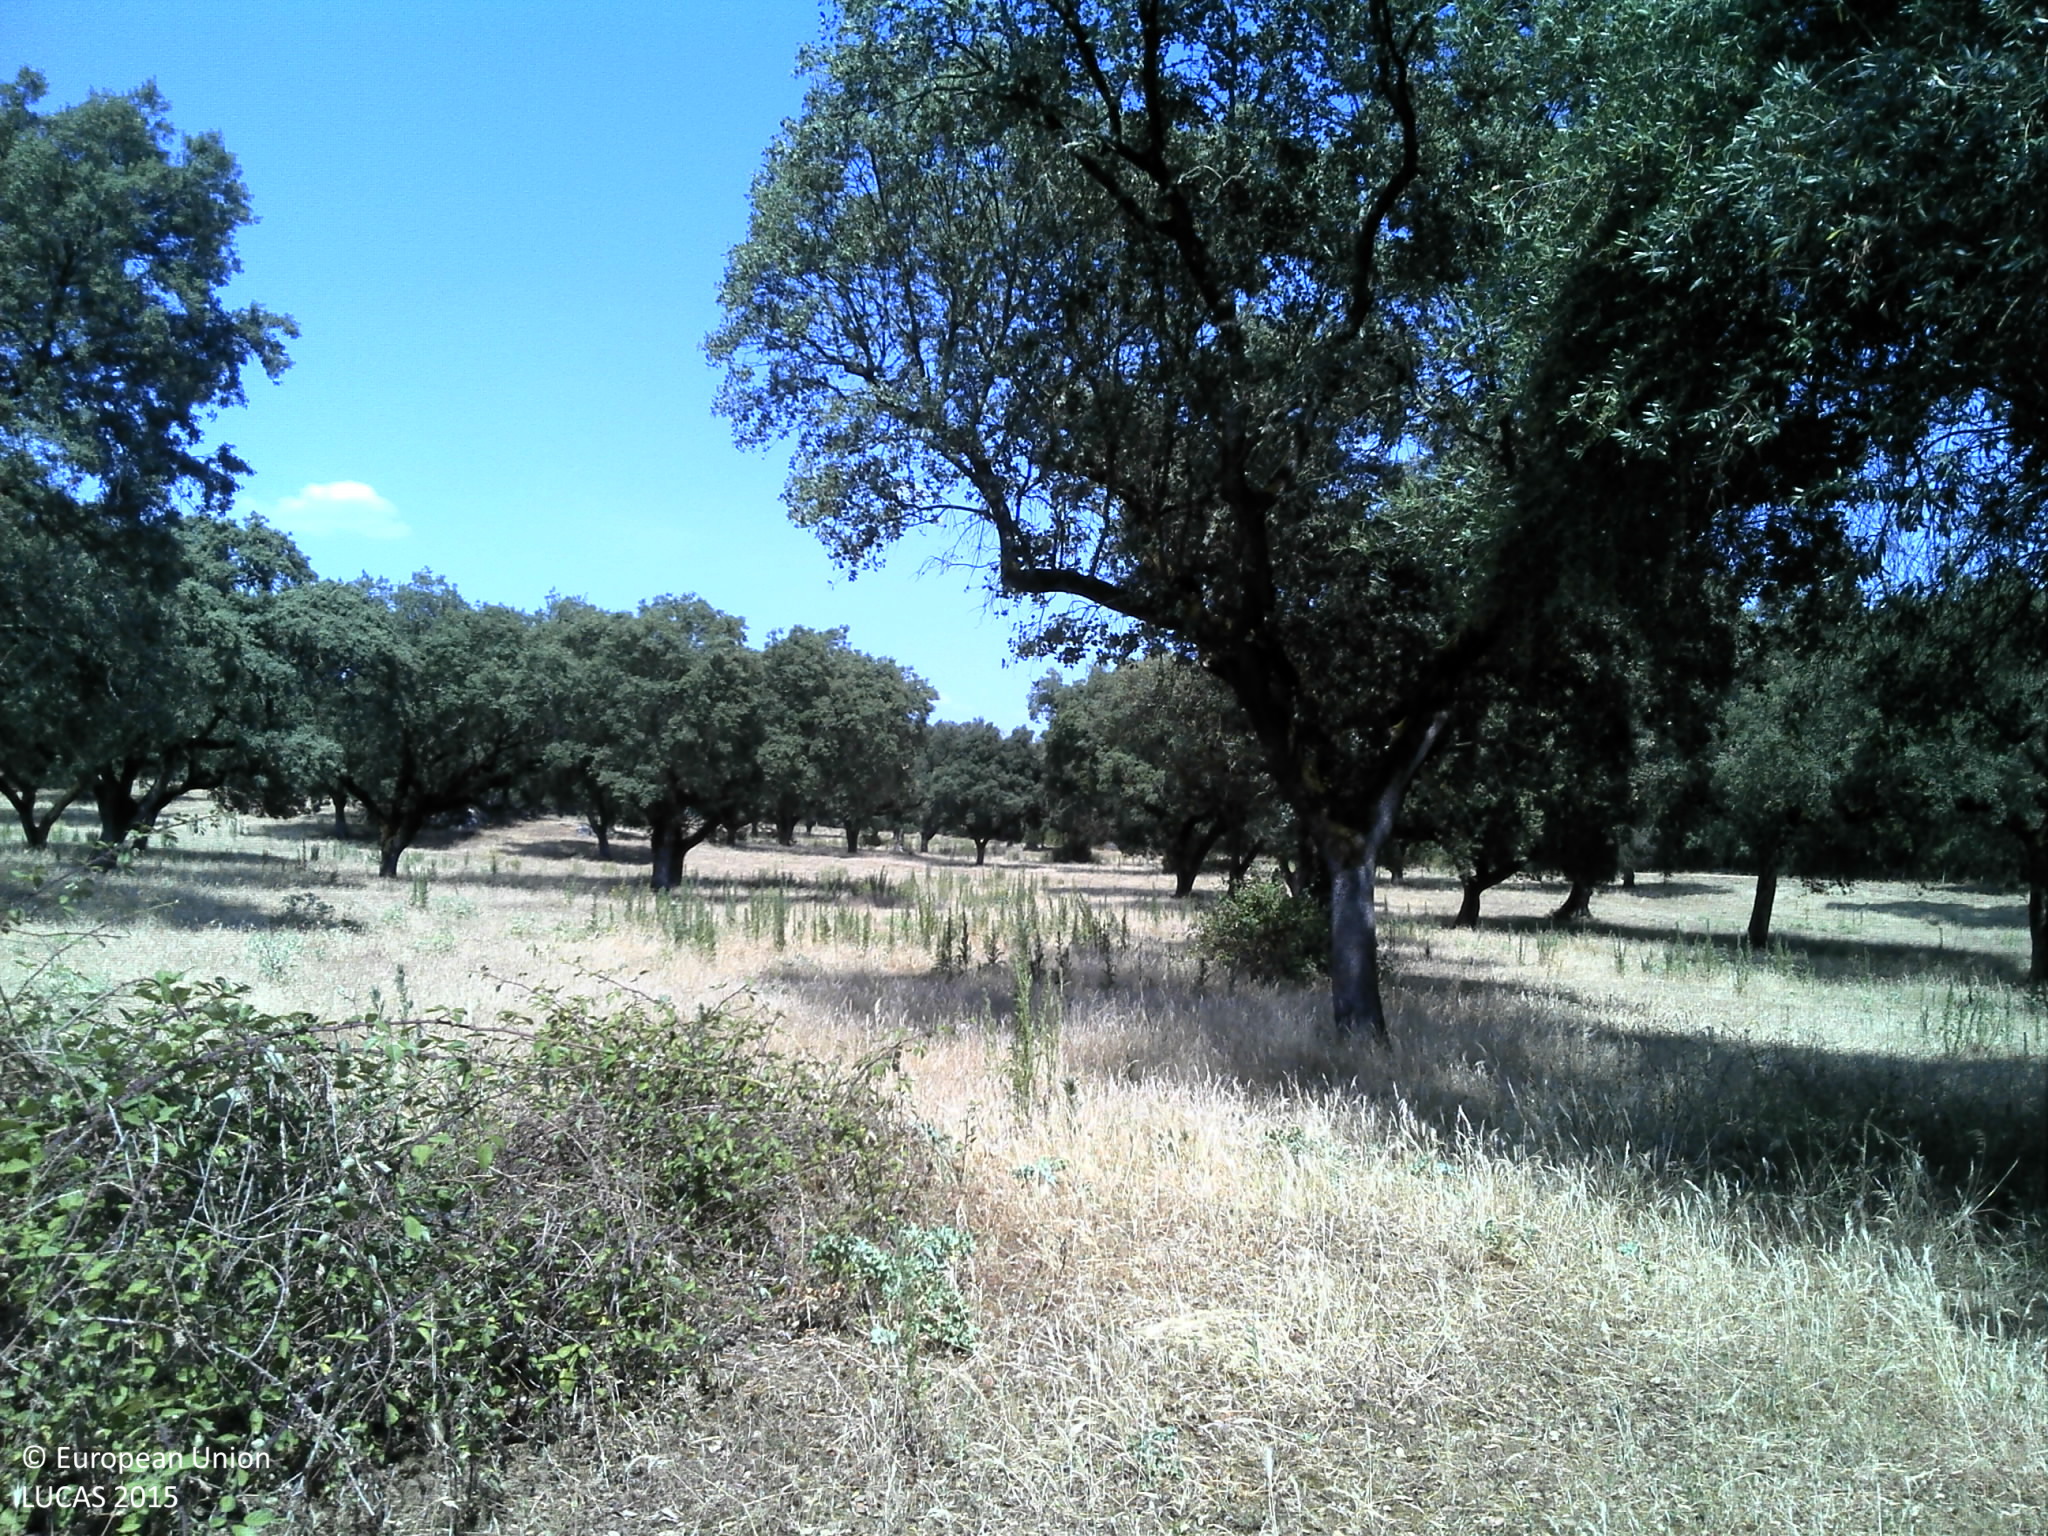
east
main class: Woodland
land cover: Broadleaved woodland
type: broadleaved evergreen forest
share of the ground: 50 - 75 %
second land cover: Grassland without tree/shrub cover
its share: 10 - 25 %
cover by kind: broadleaved forest trees 60 %, herbaceous plants 25 %, unconsolidated bare surface 15 %
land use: Forestry
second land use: Agriculture (excluding fallow land and kitchen gardens)
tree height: > 5 m
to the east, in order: Broadleaved woodland; Grassland without tree/shrub cover; Broadleaved woodland; Fences; Grassland with sparse tree/shrub cover; Broadleaved woodland
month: June
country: PT
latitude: 38.6697
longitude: -8.2439
